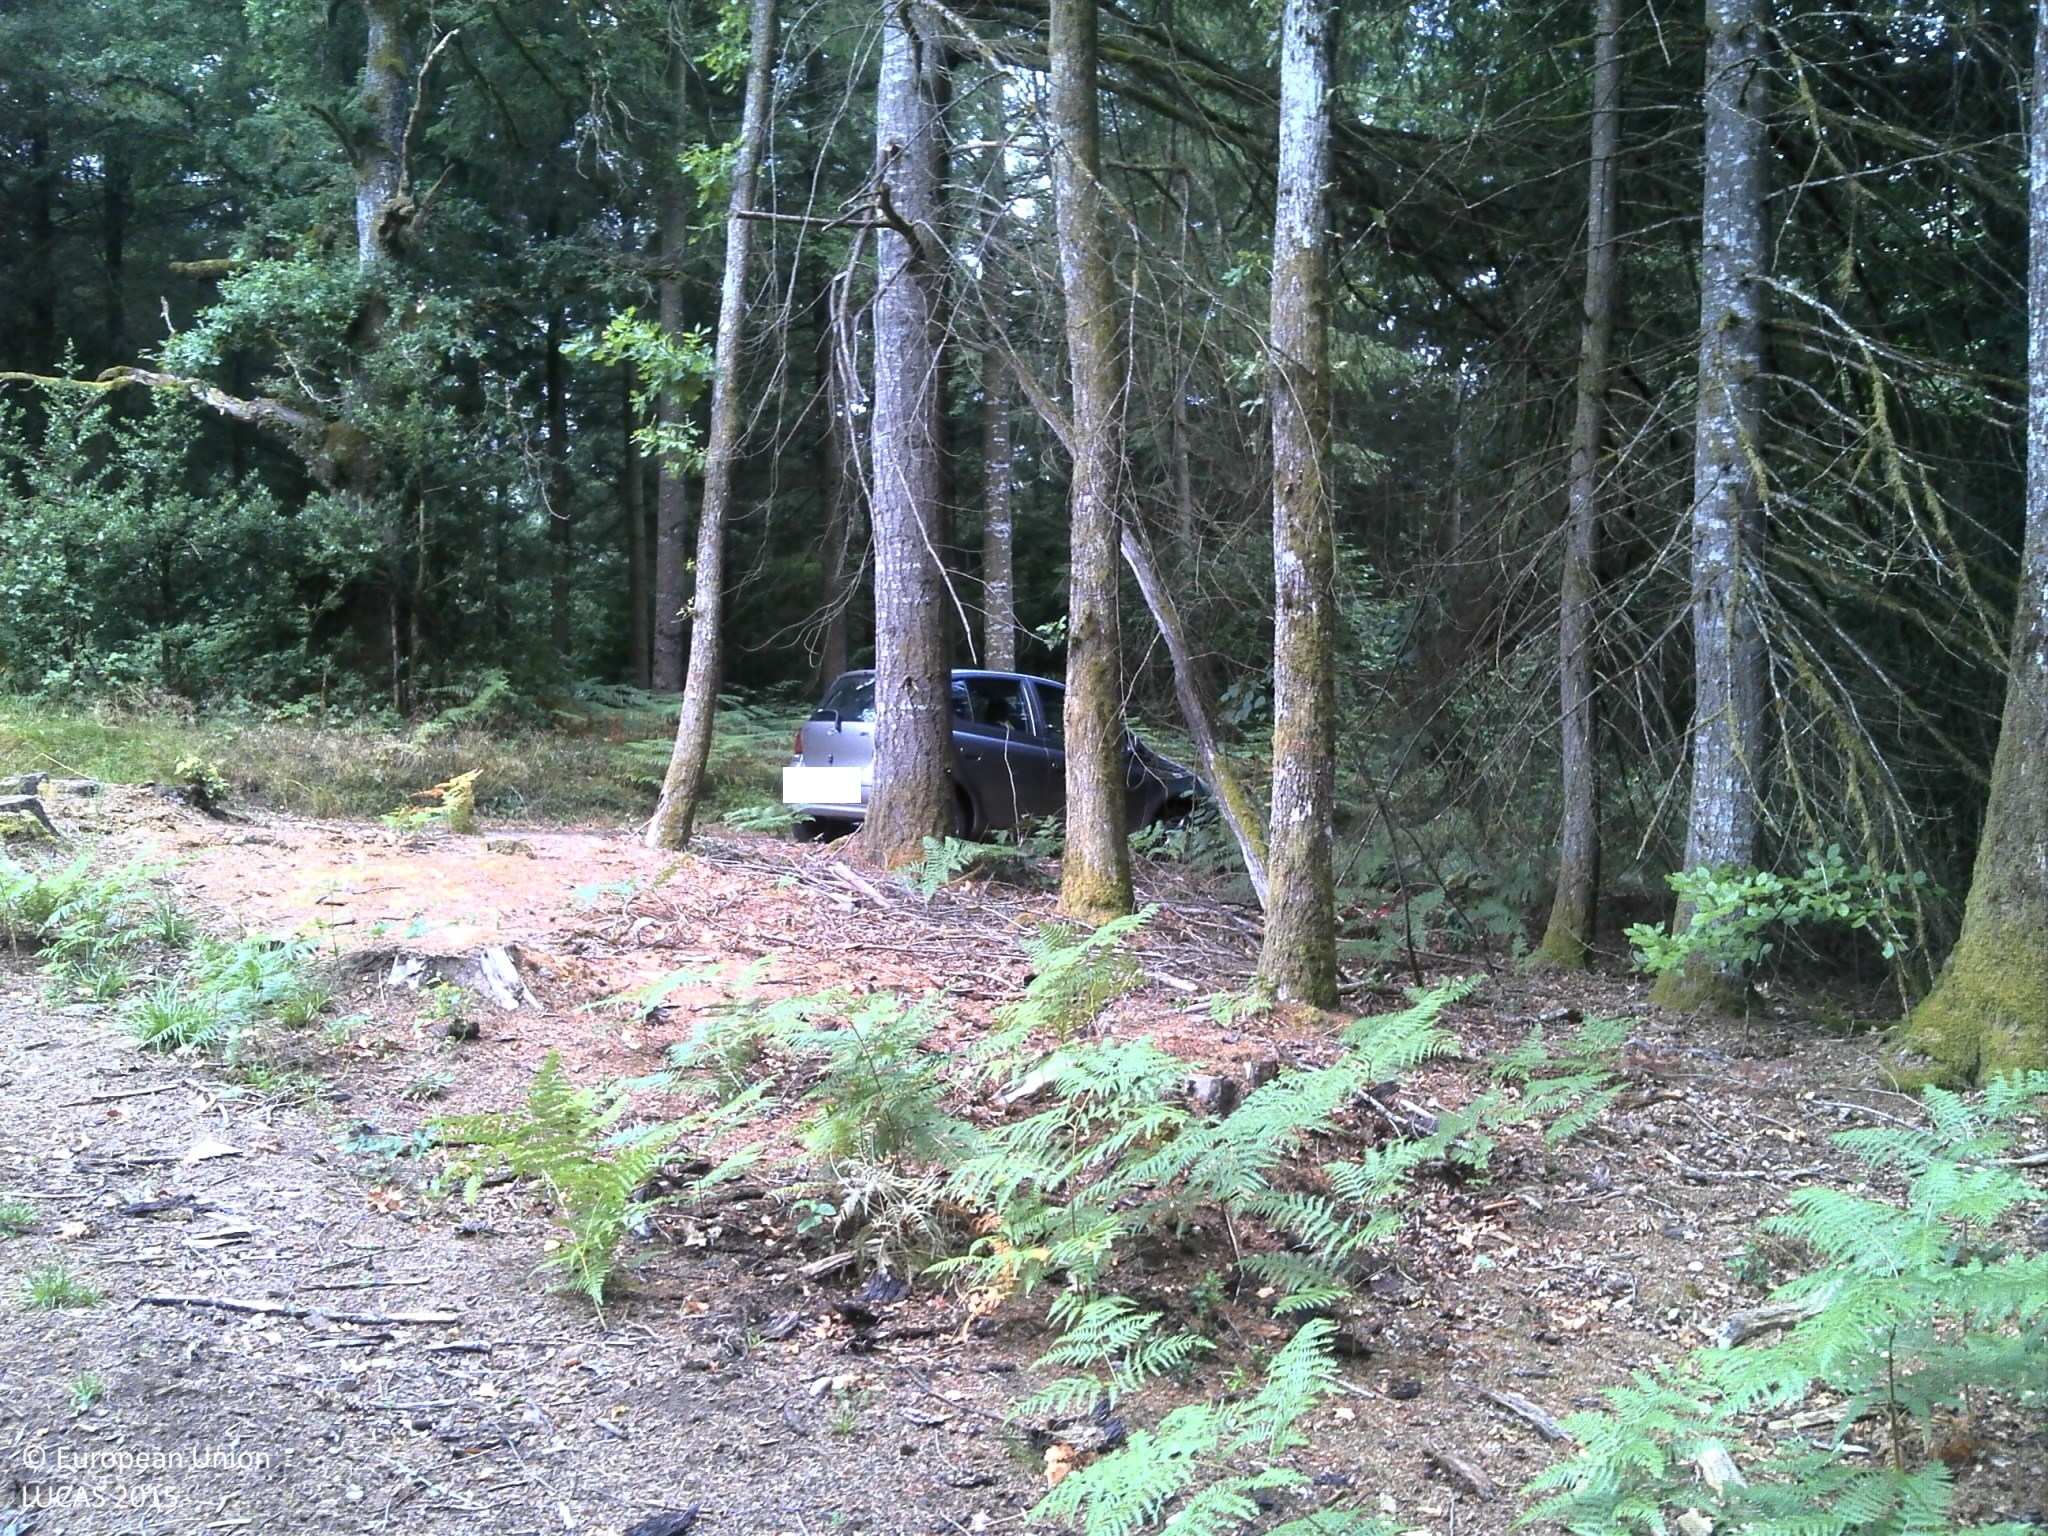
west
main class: Woodland
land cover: Spruce dominated coniferous woodland
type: exotic forest
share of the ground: > 75 %
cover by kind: coniferous forest trees 55 %, herbaceous plants 20 %, unconsolidated bare surface 20 %, lichens and mosses 5 %
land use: Forestry
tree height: > 5 m
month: August
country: FR
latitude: 45.5882
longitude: 2.3454
